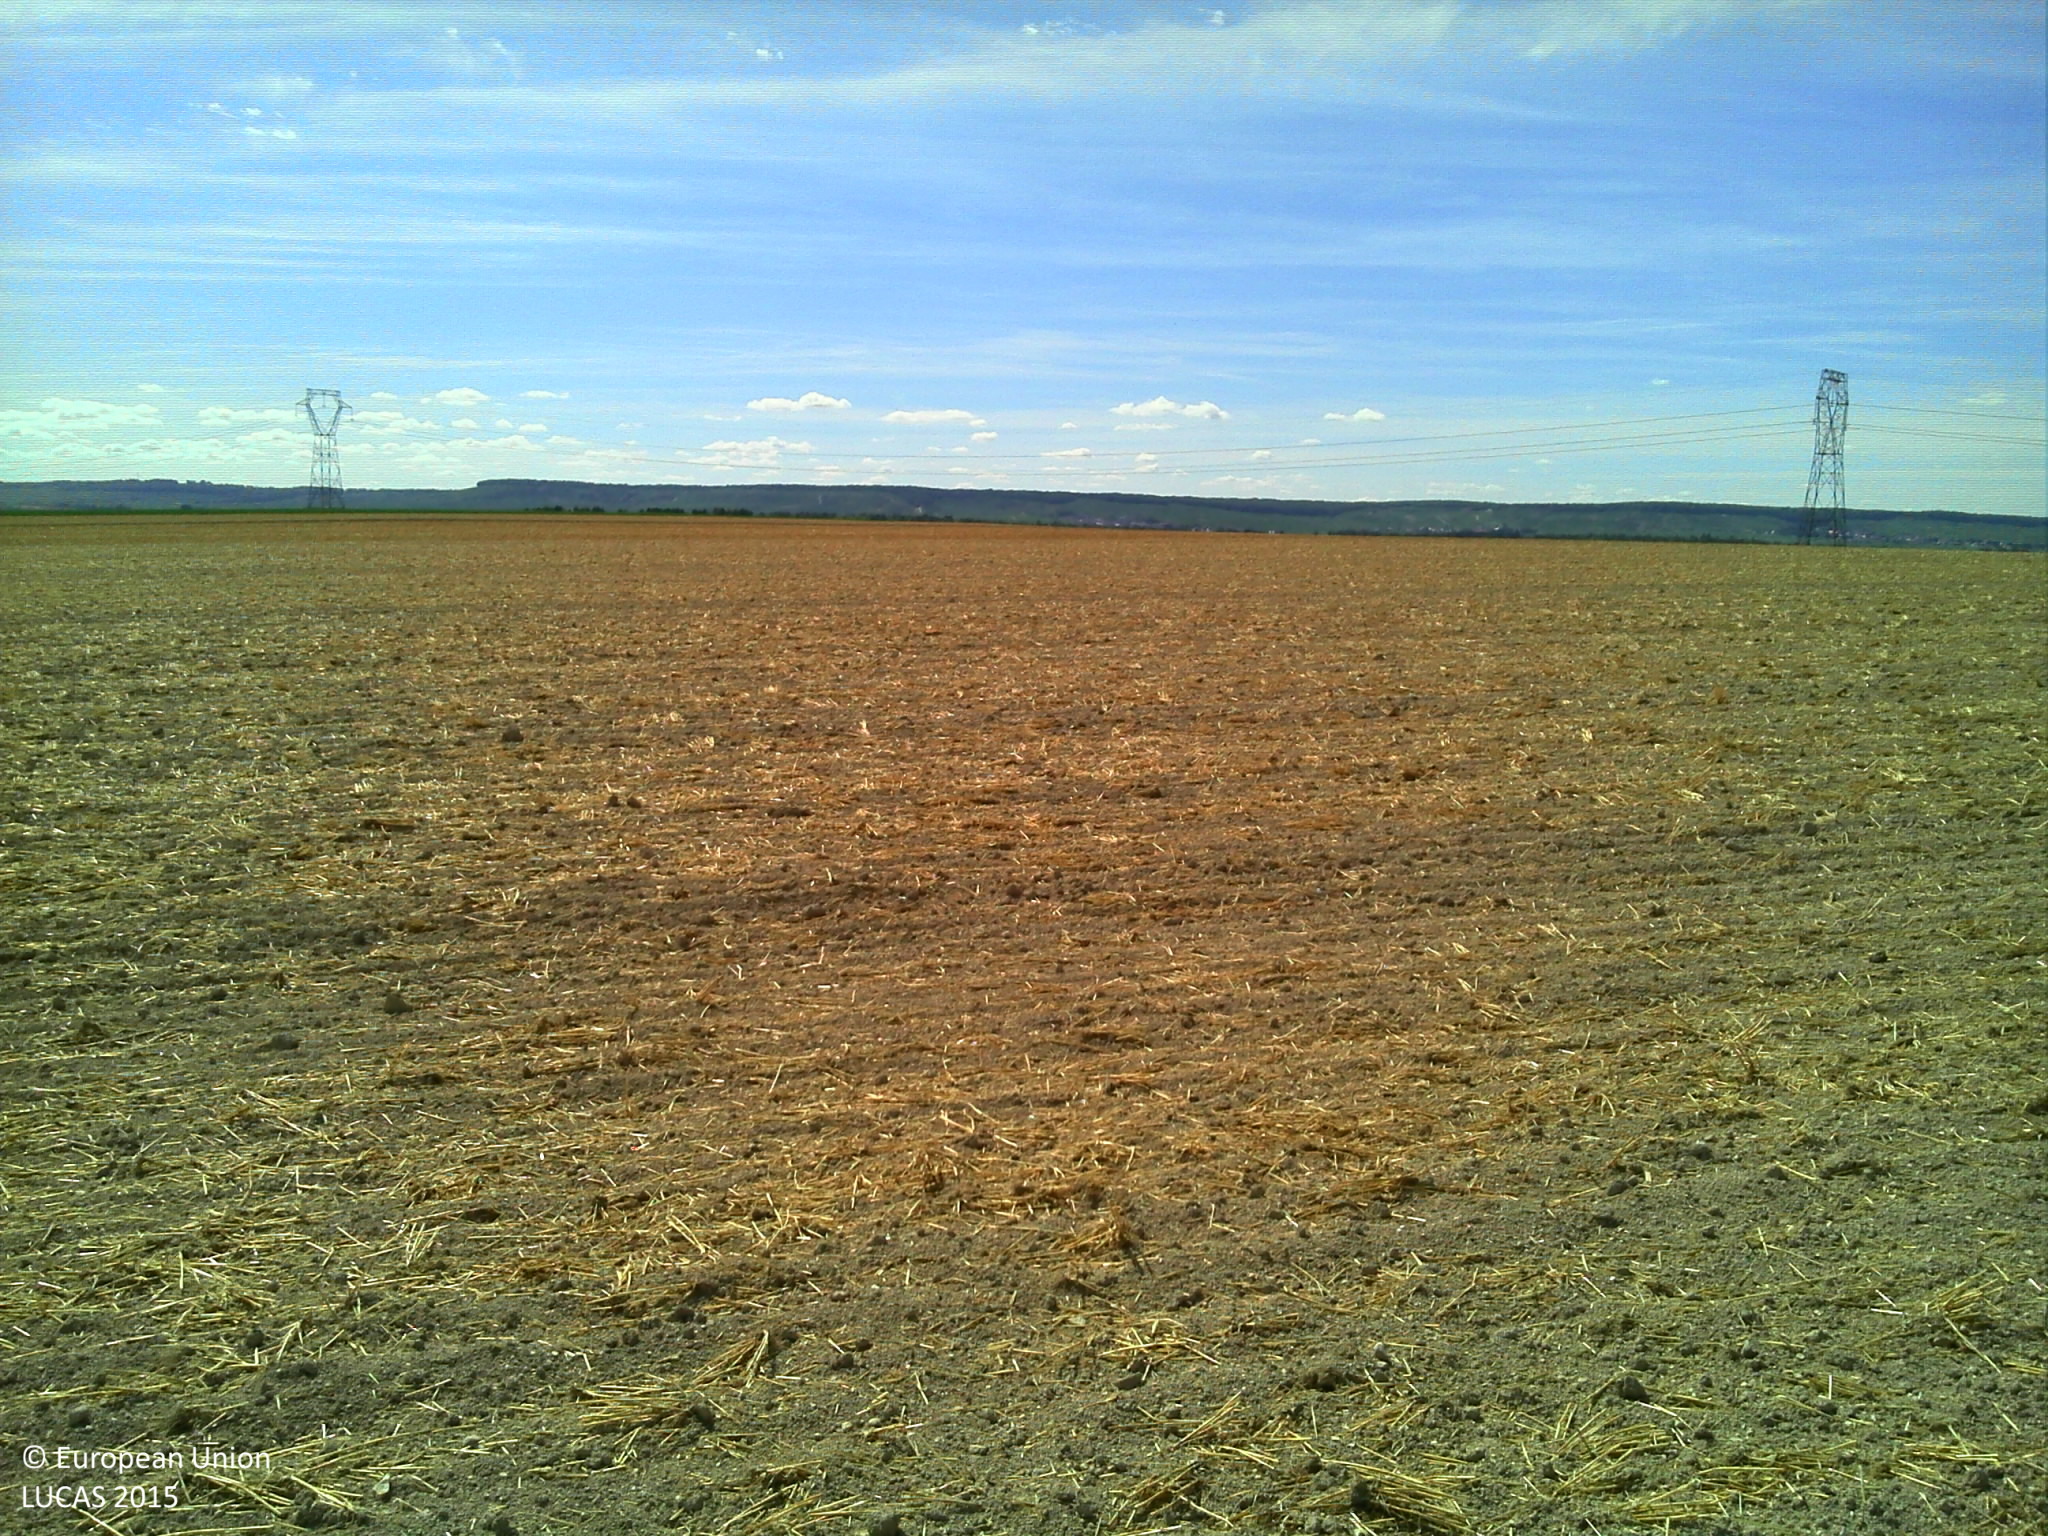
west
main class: Cropland
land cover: Common wheat
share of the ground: > 75 %
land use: Agriculture (excluding fallow land and kitchen gardens)
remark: Tilled/Sowed
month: August
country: FR
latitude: 48.9500
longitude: 4.1102
